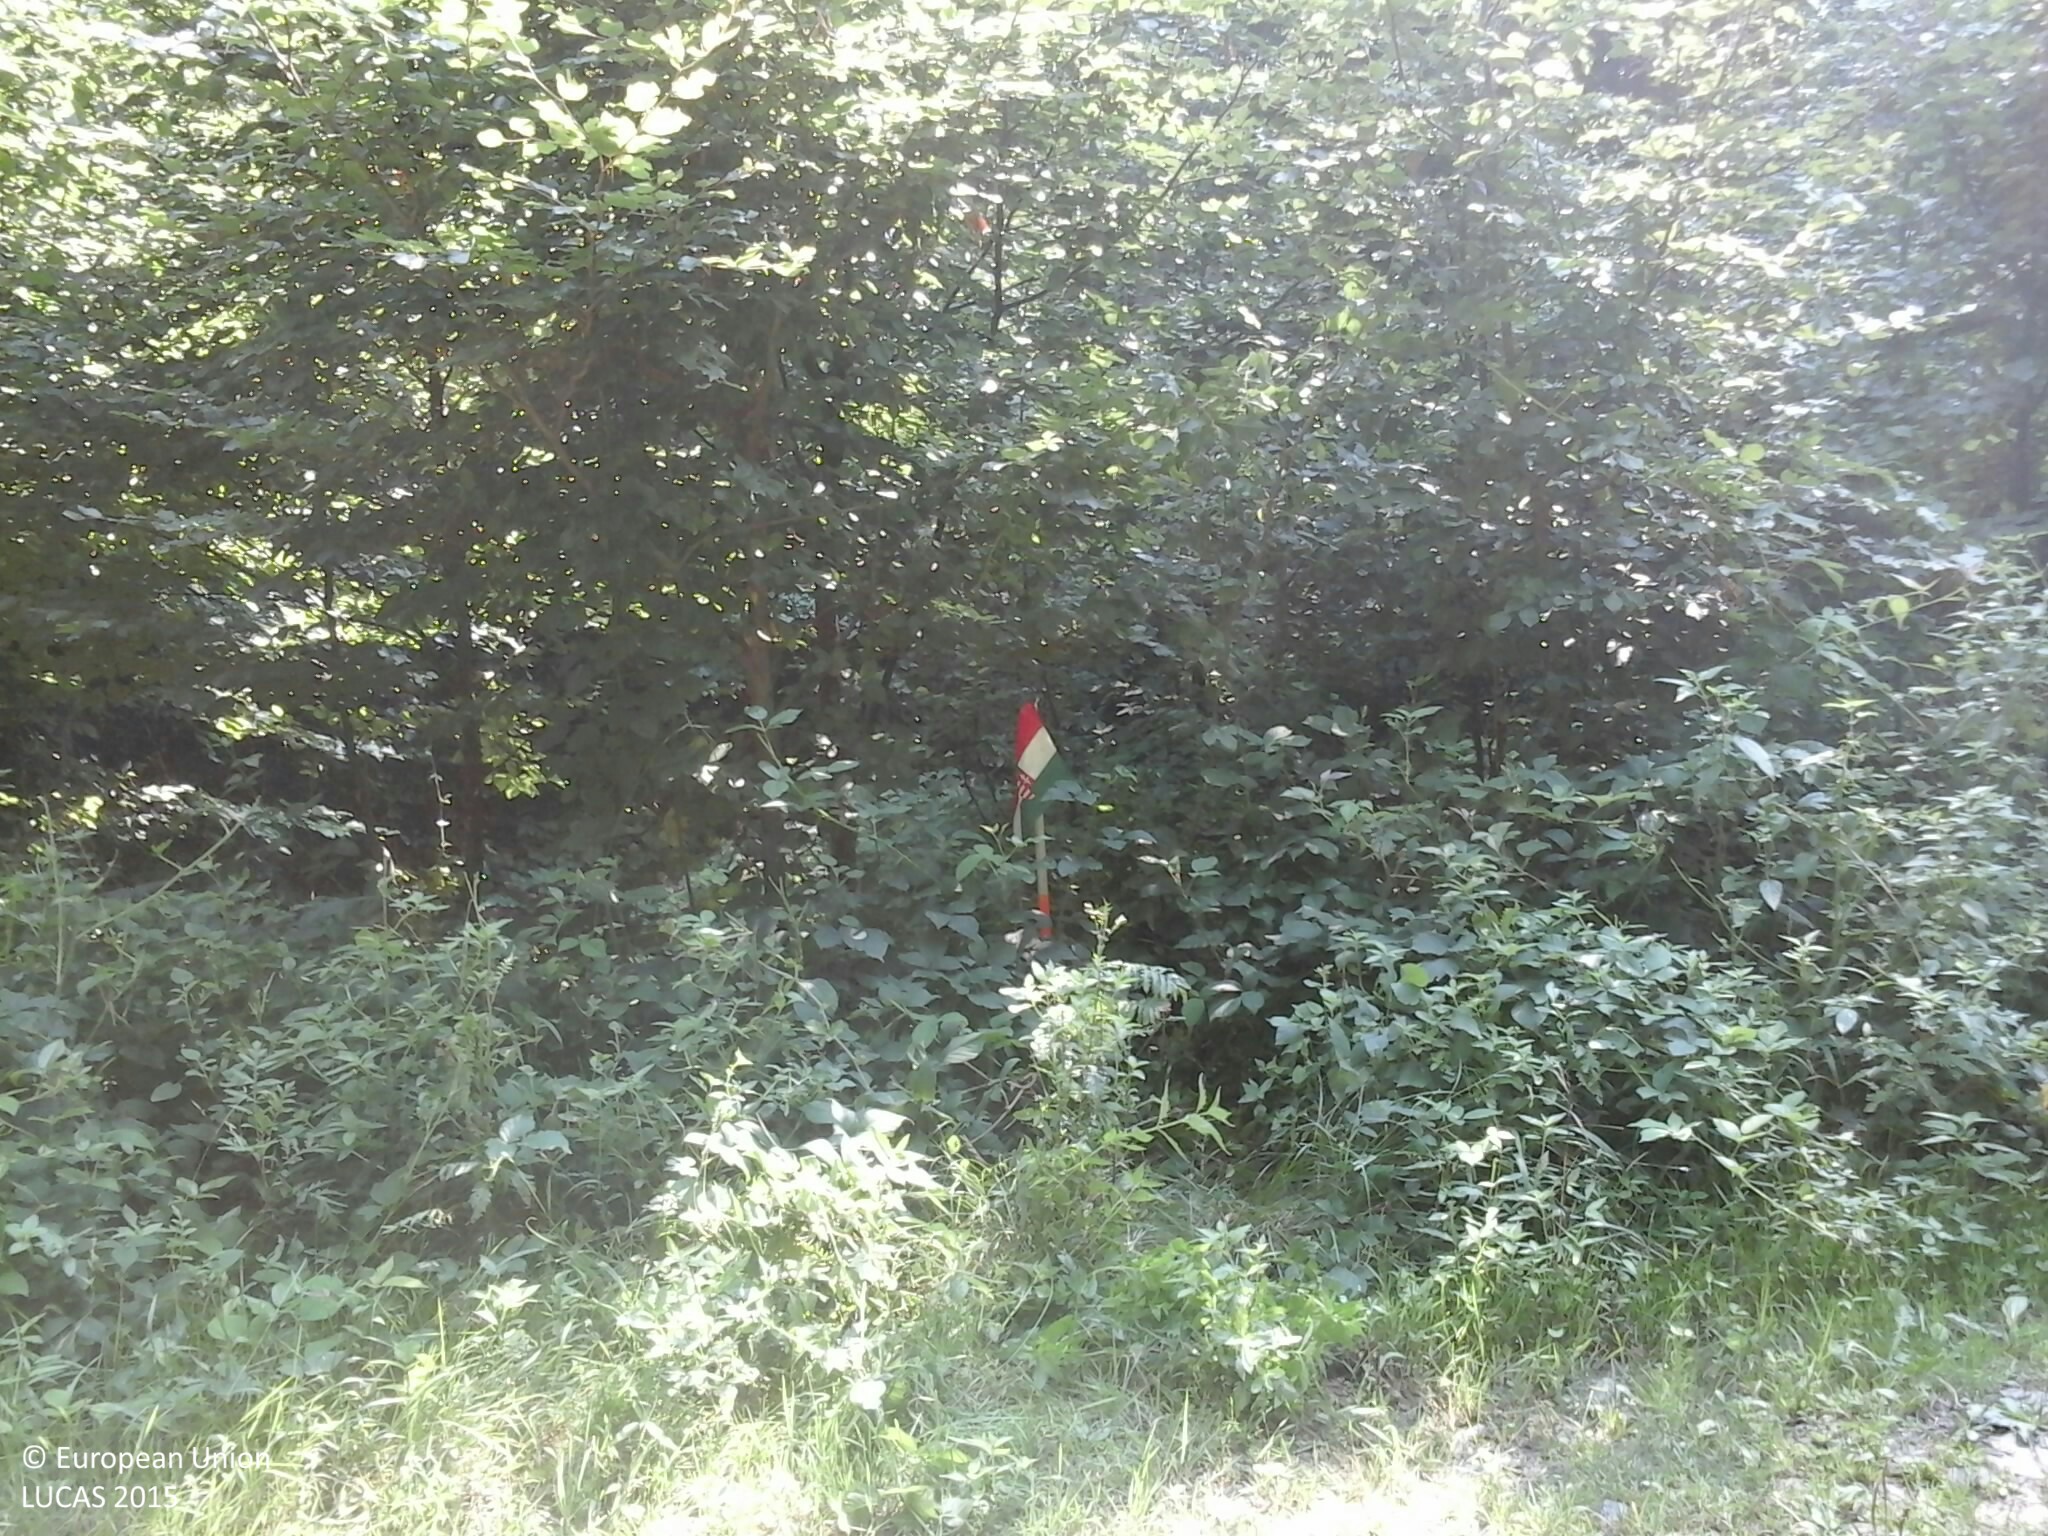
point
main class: Woodland
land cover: Broadleaved woodland
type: beech forest
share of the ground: > 75 %
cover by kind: broadleaved forest trees 100 %
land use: Forestry
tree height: > 5 m
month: August
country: HU
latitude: 46.1285
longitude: 18.1737
